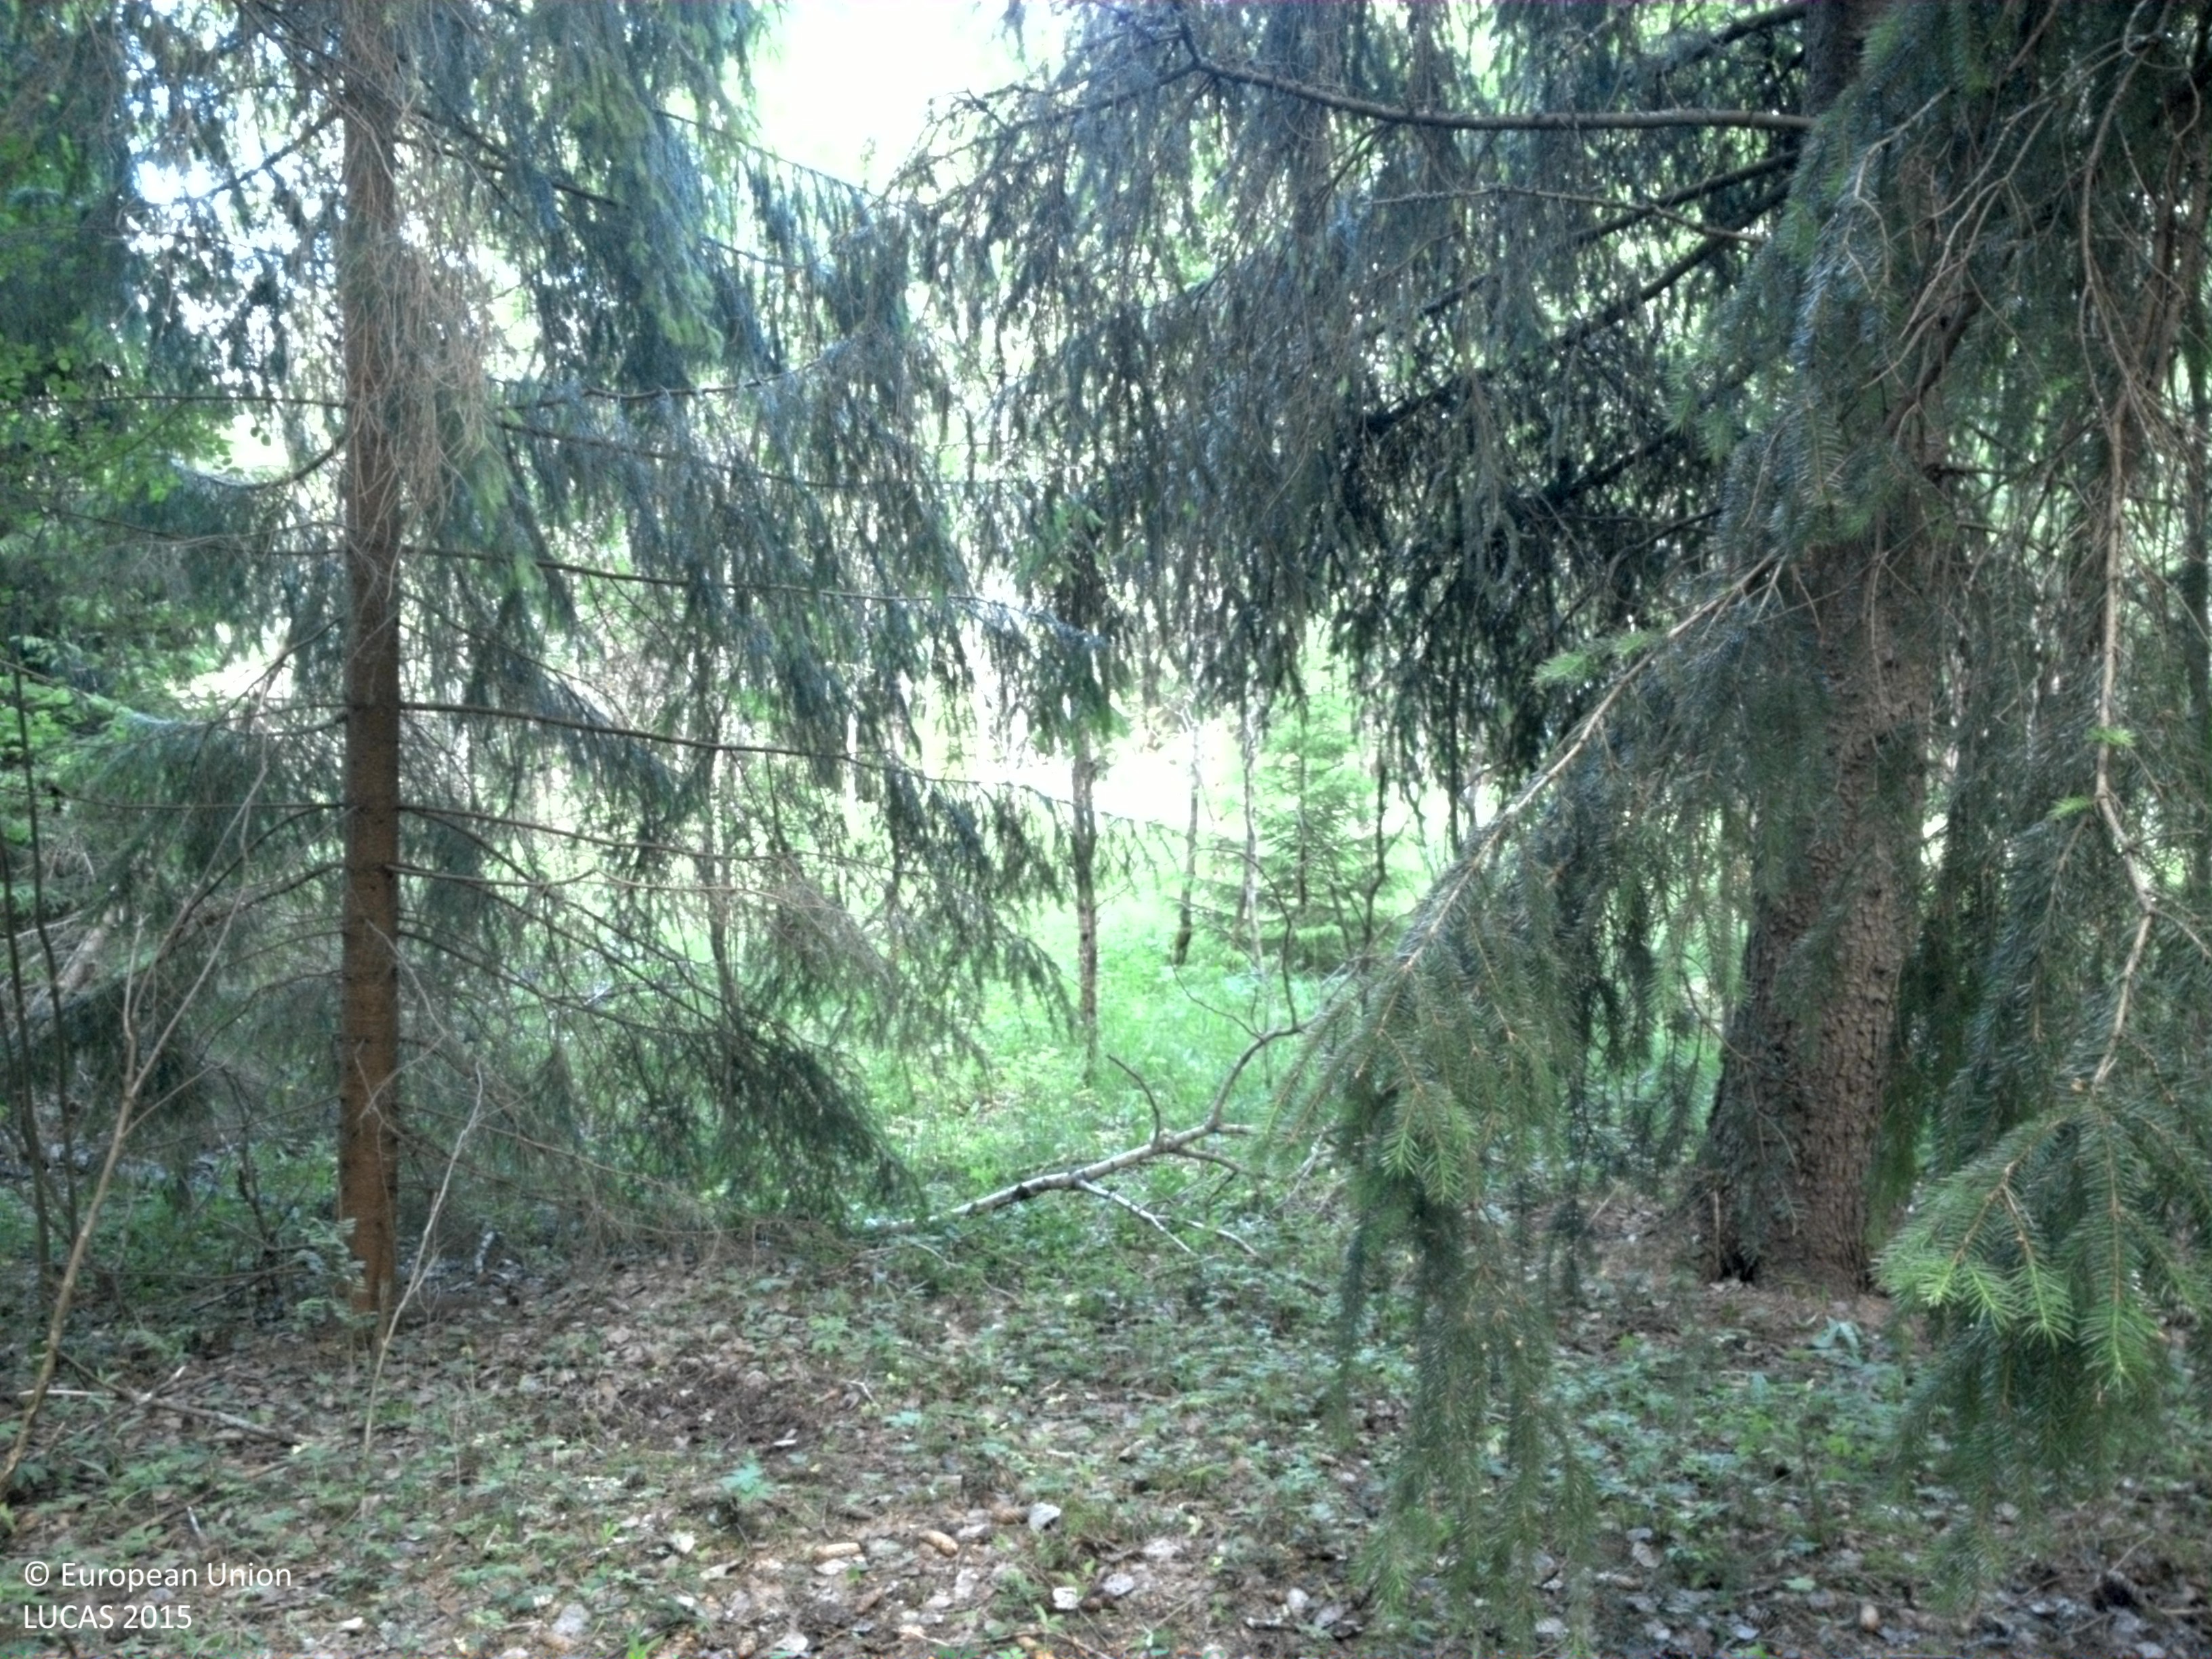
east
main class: Woodland
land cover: Spruce dominated coniferous woodland
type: boreal forest
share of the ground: > 75 %
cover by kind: coniferous forest trees 80 %, broadleaved forest trees 10 %, herbaceous plants 10 %
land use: Forestry
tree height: > 5 m
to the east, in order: Spruce dominated coniferous woodland; Spruce dominated mixed woodland; Spruce dominated coniferous woodland; Broadleaved woodland; Ditches and canals; Broadleaved woodland; Other leguminous and mixtures for fodder; Broadleaved woodland
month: June
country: SE
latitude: 60.1802
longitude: 17.1485
